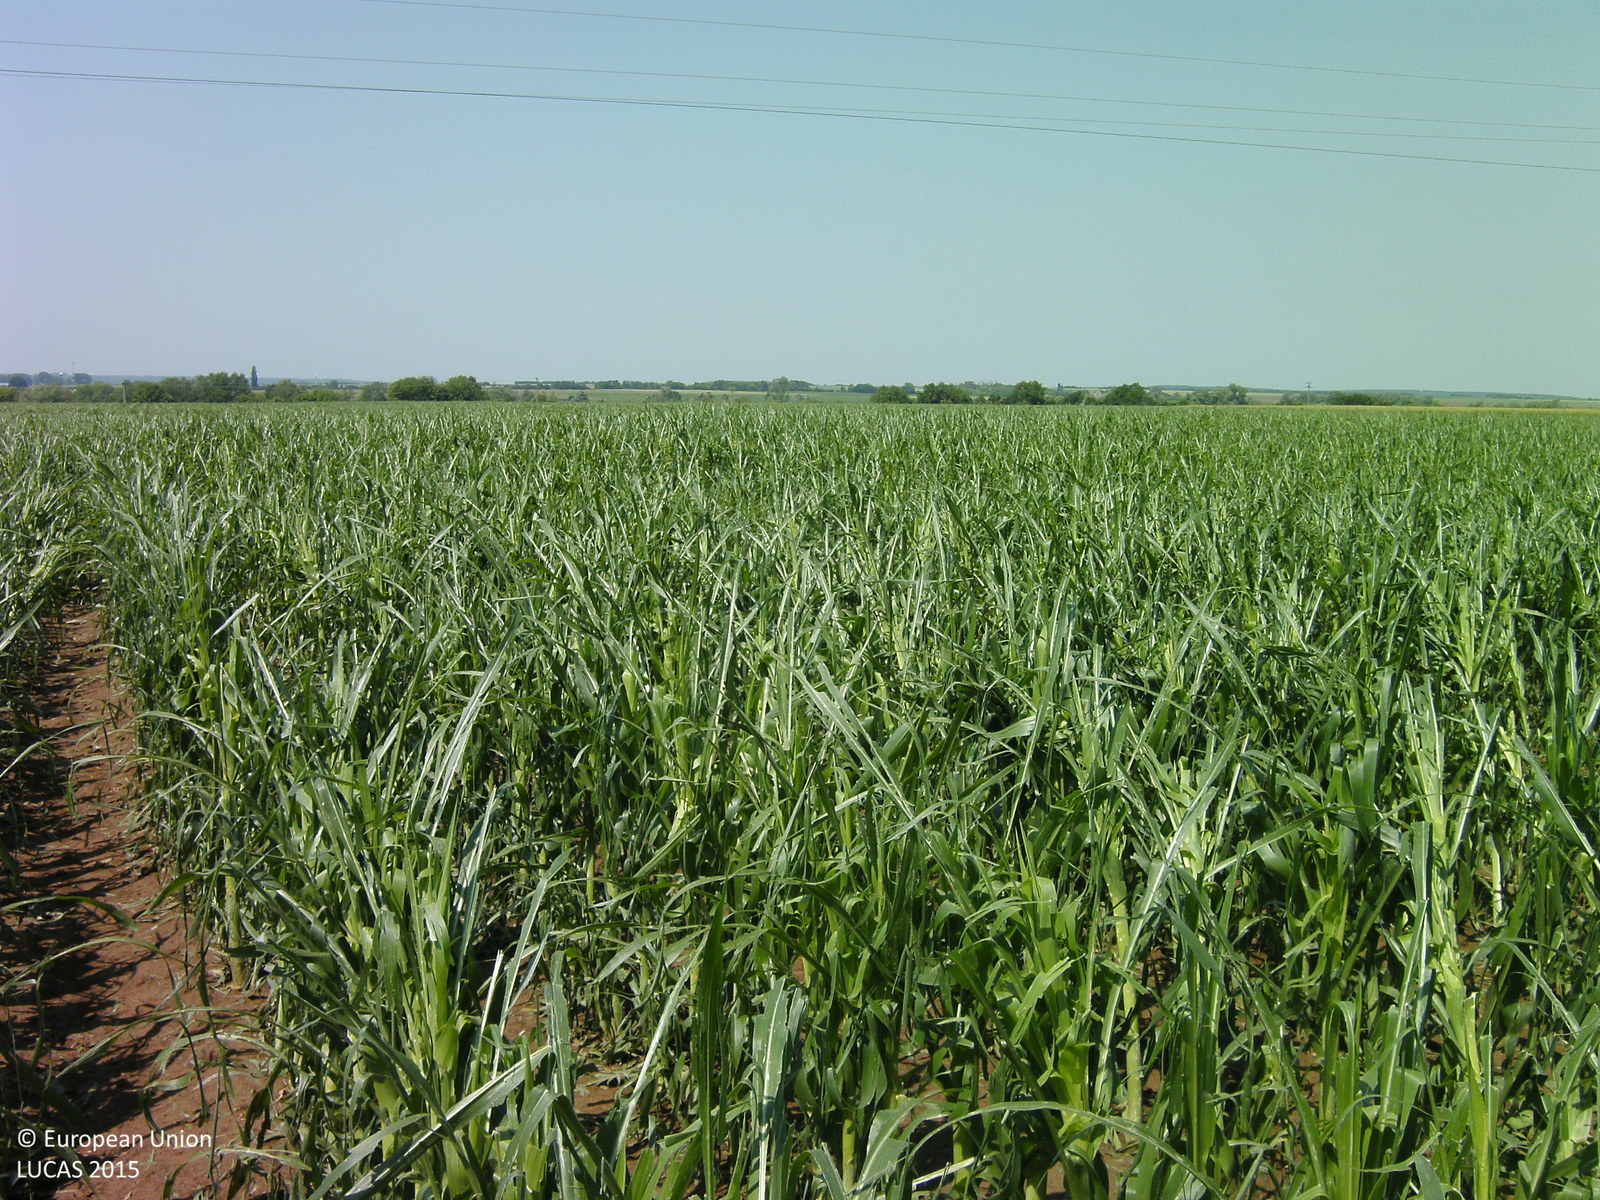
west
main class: Cropland
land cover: Maize
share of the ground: 50 - 75 %
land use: Agriculture (excluding fallow land and kitchen gardens)
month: June
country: HU
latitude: 46.3748
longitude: 18.0284
